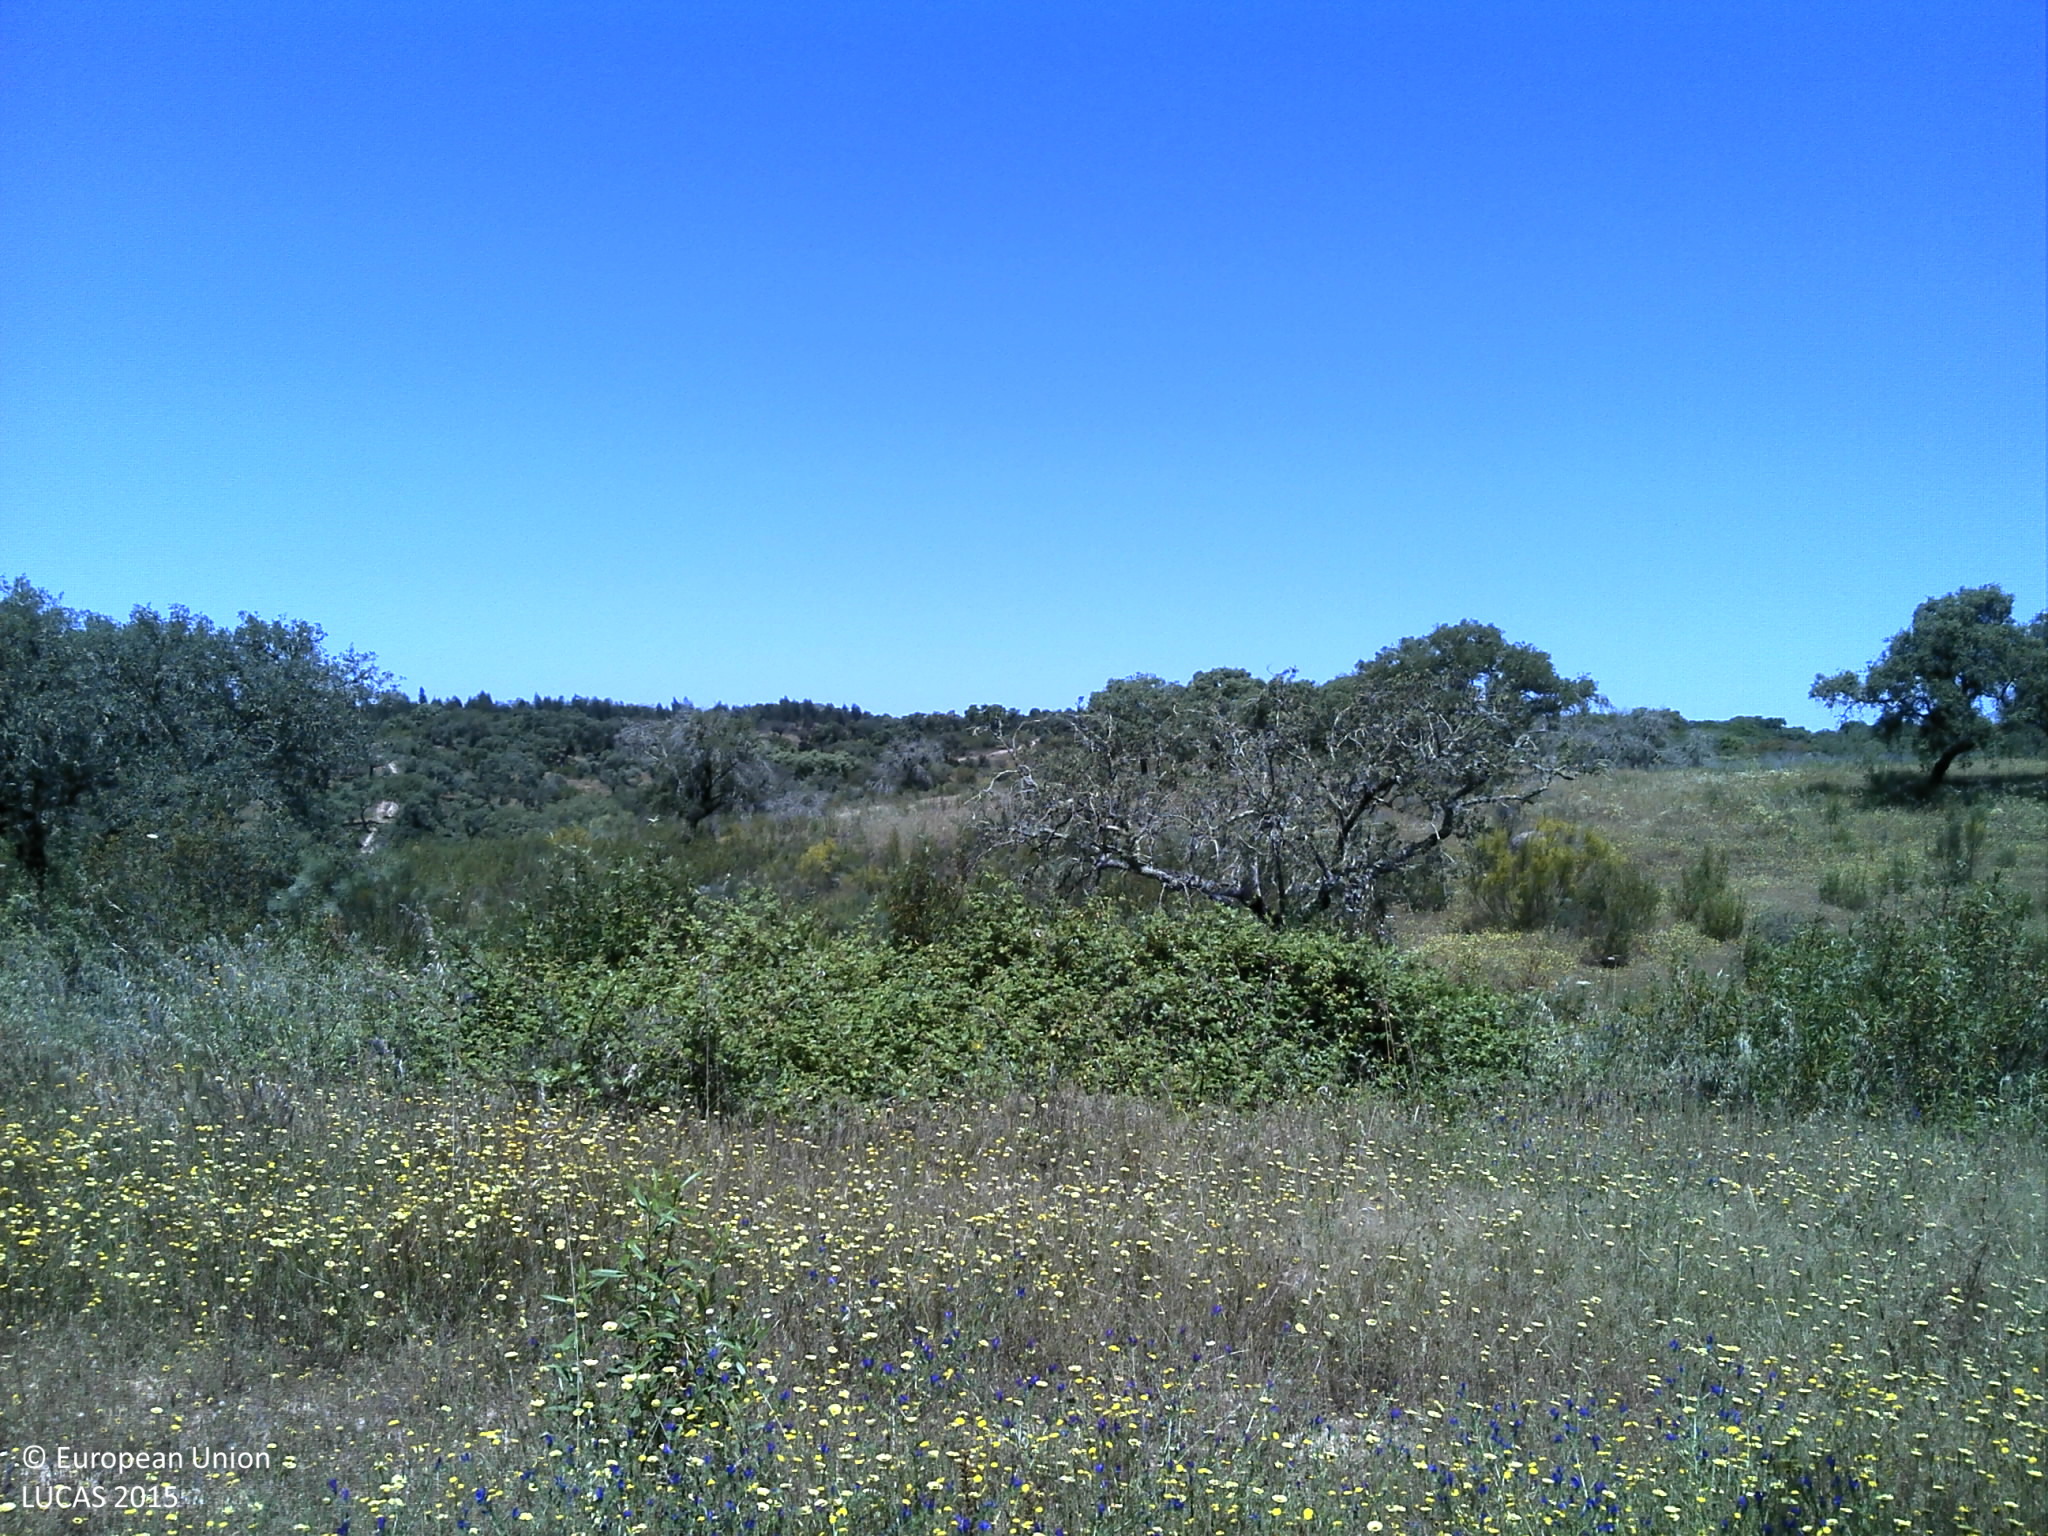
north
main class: Woodland
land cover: Broadleaved woodland
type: broadleaved evergreen forest
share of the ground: 10 - 25 %
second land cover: Grassland without tree/shrub cover
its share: 25 - 50 %
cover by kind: broadleaved forest trees 25 %, shrubs 25 %, herbaceous plants 25 %, unconsolidated bare surface 25 %
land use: Forestry
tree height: > 5 m
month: May
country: PT
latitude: 39.2068
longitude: -7.8492
